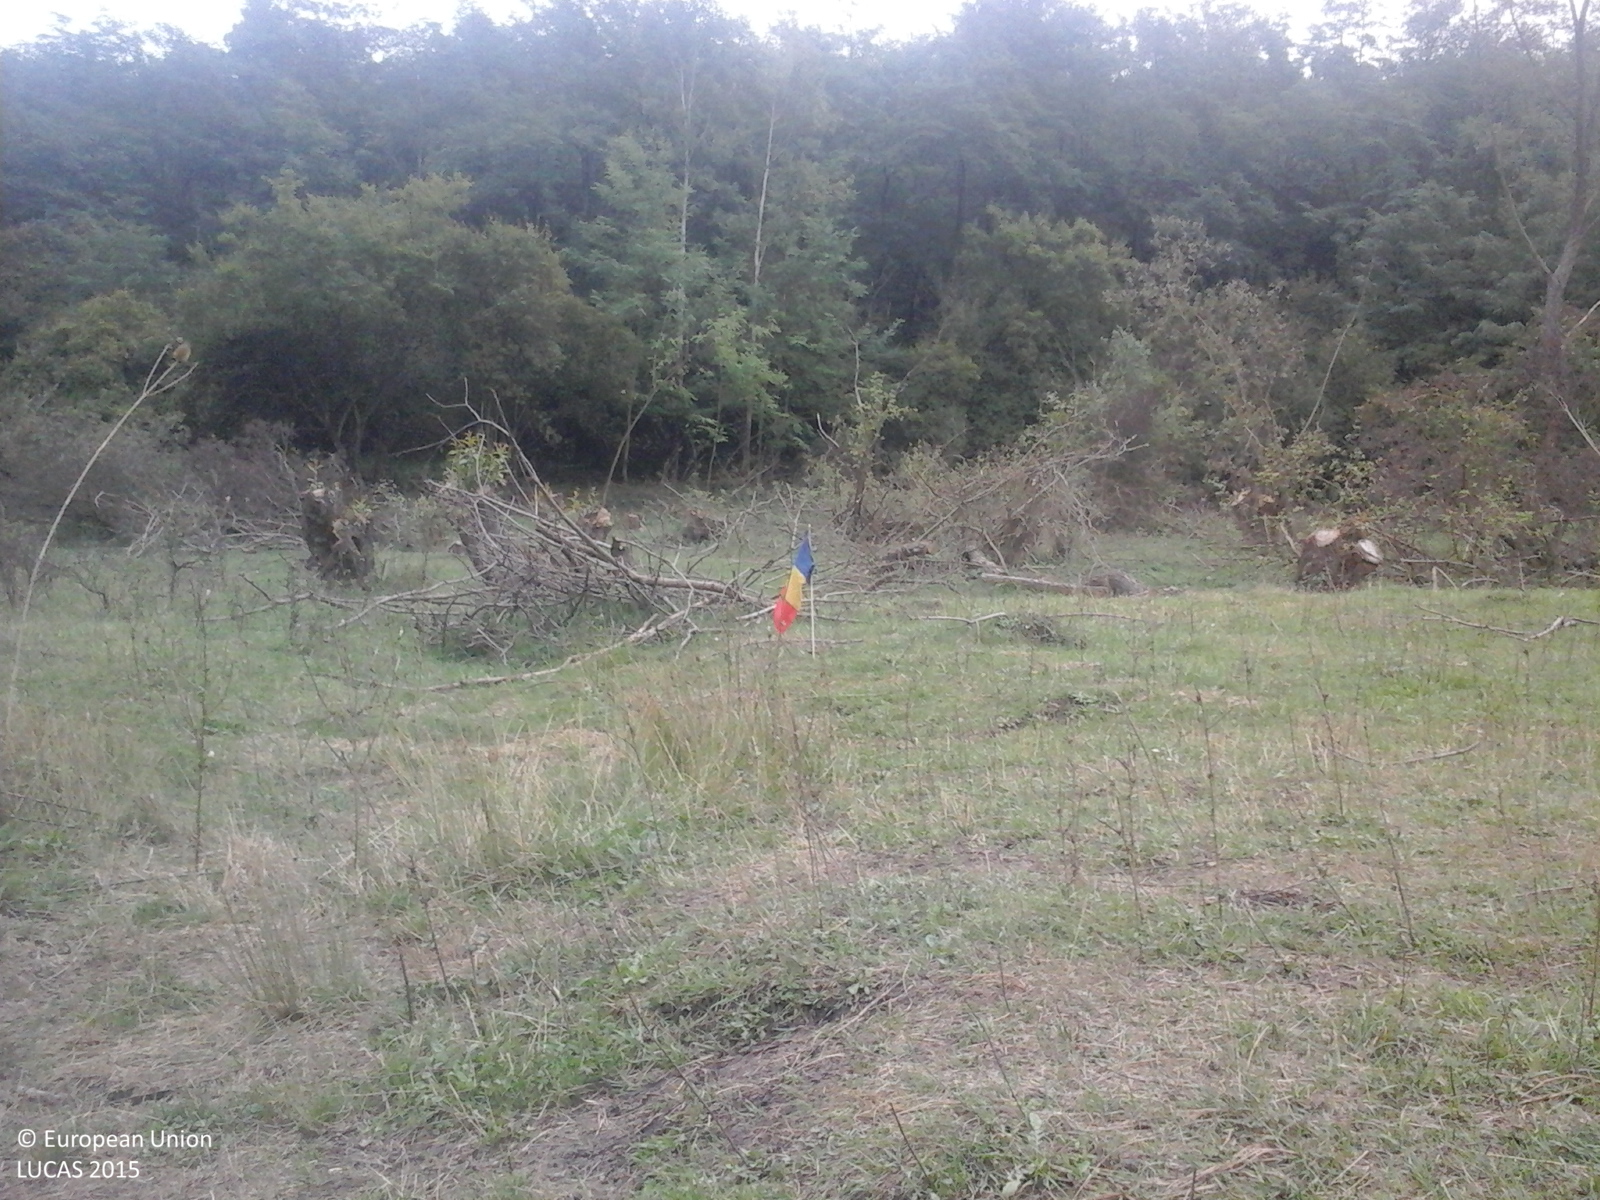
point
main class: Grassland
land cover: Grassland with sparse tree/shrub cover
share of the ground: > 75 %
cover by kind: herbaceous plants 85 %, shrubs 10 %, broadleaved forest trees 5 %
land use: Agriculture (excluding fallow land and kitchen gardens)
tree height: < 5 m
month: September
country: RO
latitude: 45.7961
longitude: 22.9580
